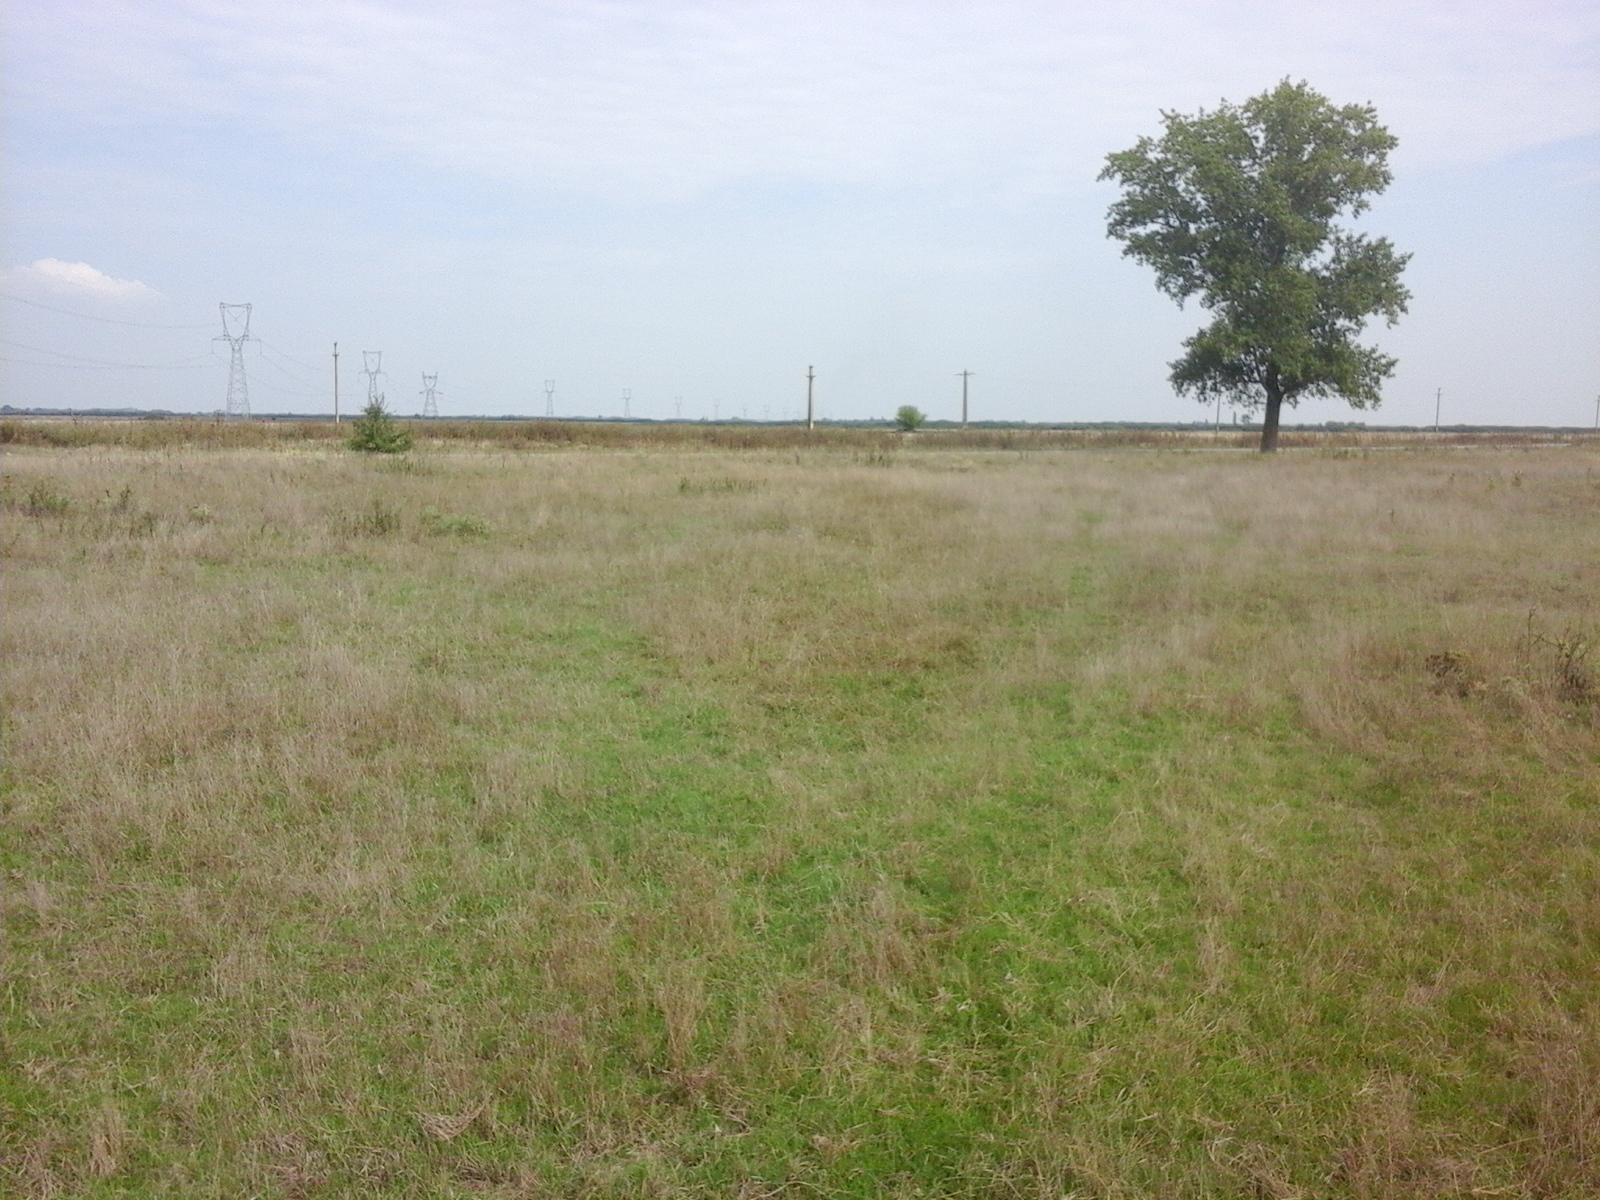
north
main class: Grassland
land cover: Spontaneously vegetated surfaces
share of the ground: > 75 %
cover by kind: herbaceous plants 100 %
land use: Fallow land
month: August
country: RO
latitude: 46.6067
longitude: 21.6204
